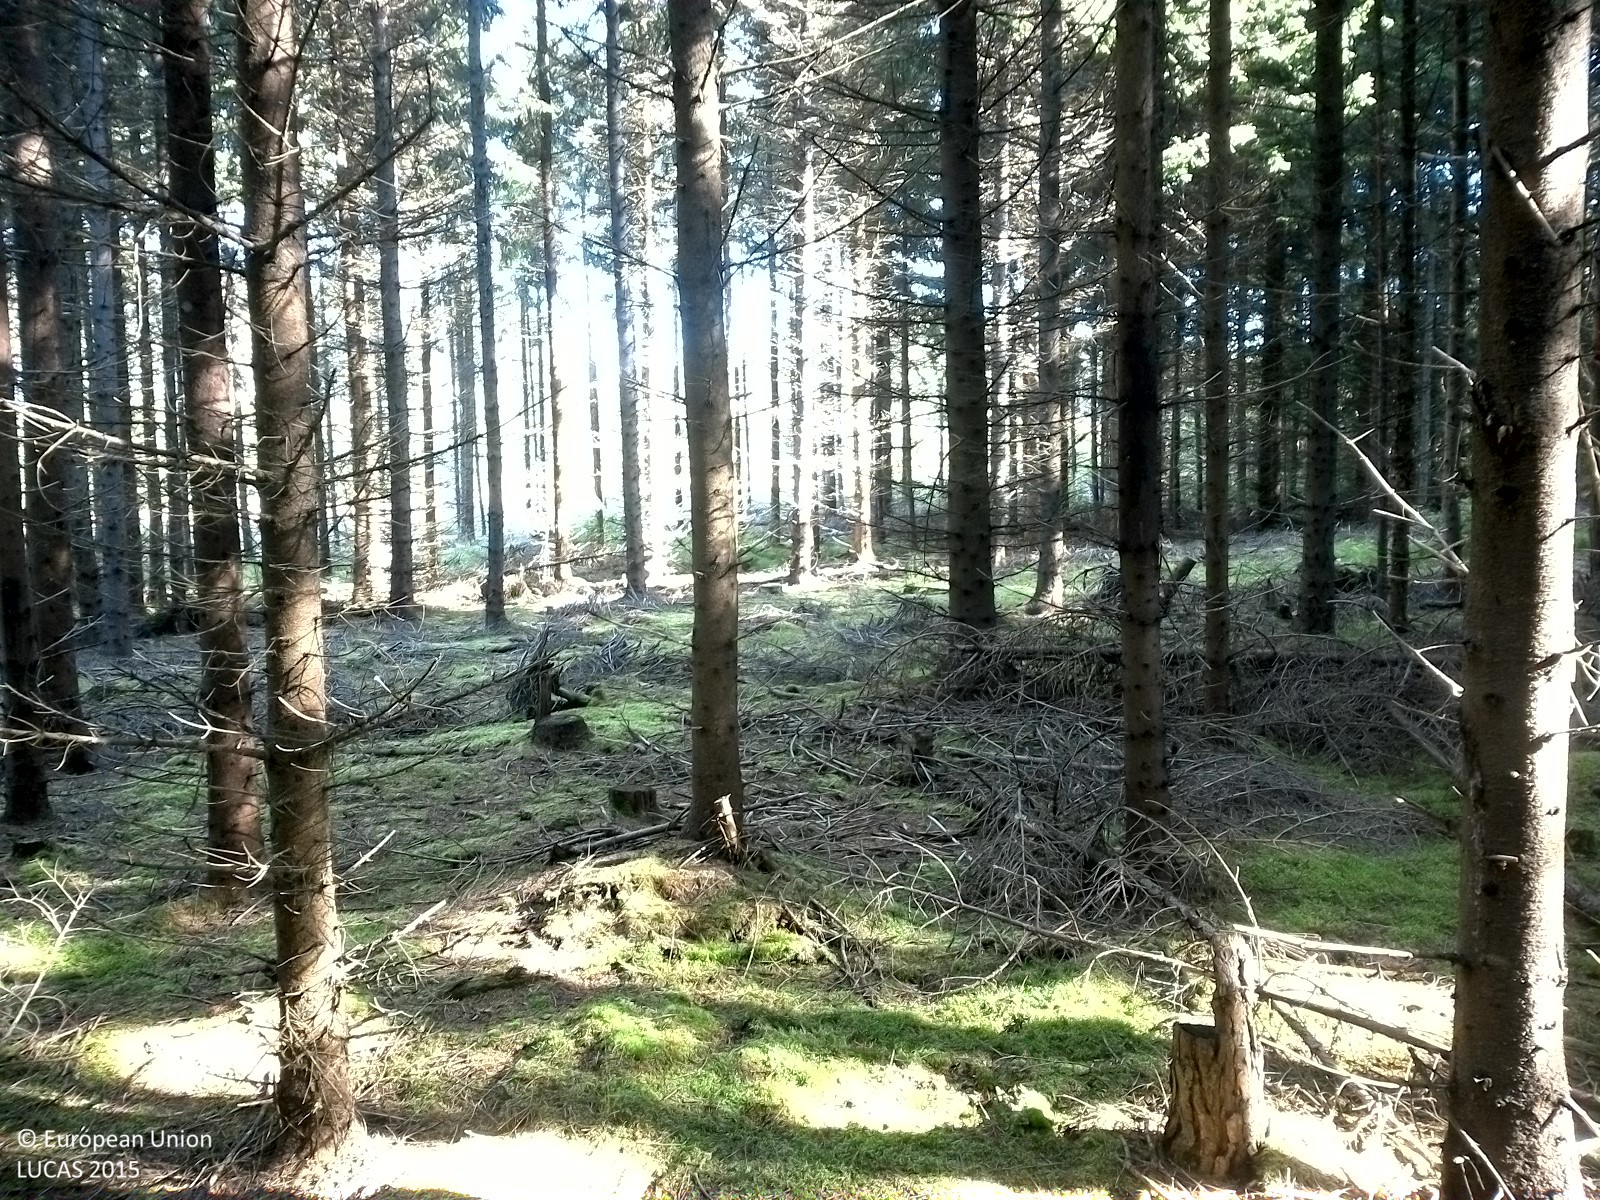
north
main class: Woodland
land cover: Spruce dominated coniferous woodland
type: boreal forest
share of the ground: 50 - 75 %
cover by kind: coniferous forest trees 65 %, lichens and mosses 30 %, herbaceous plants 5 %
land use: Forestry
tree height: > 5 m
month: August
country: SE
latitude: 59.0449
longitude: 15.0295
